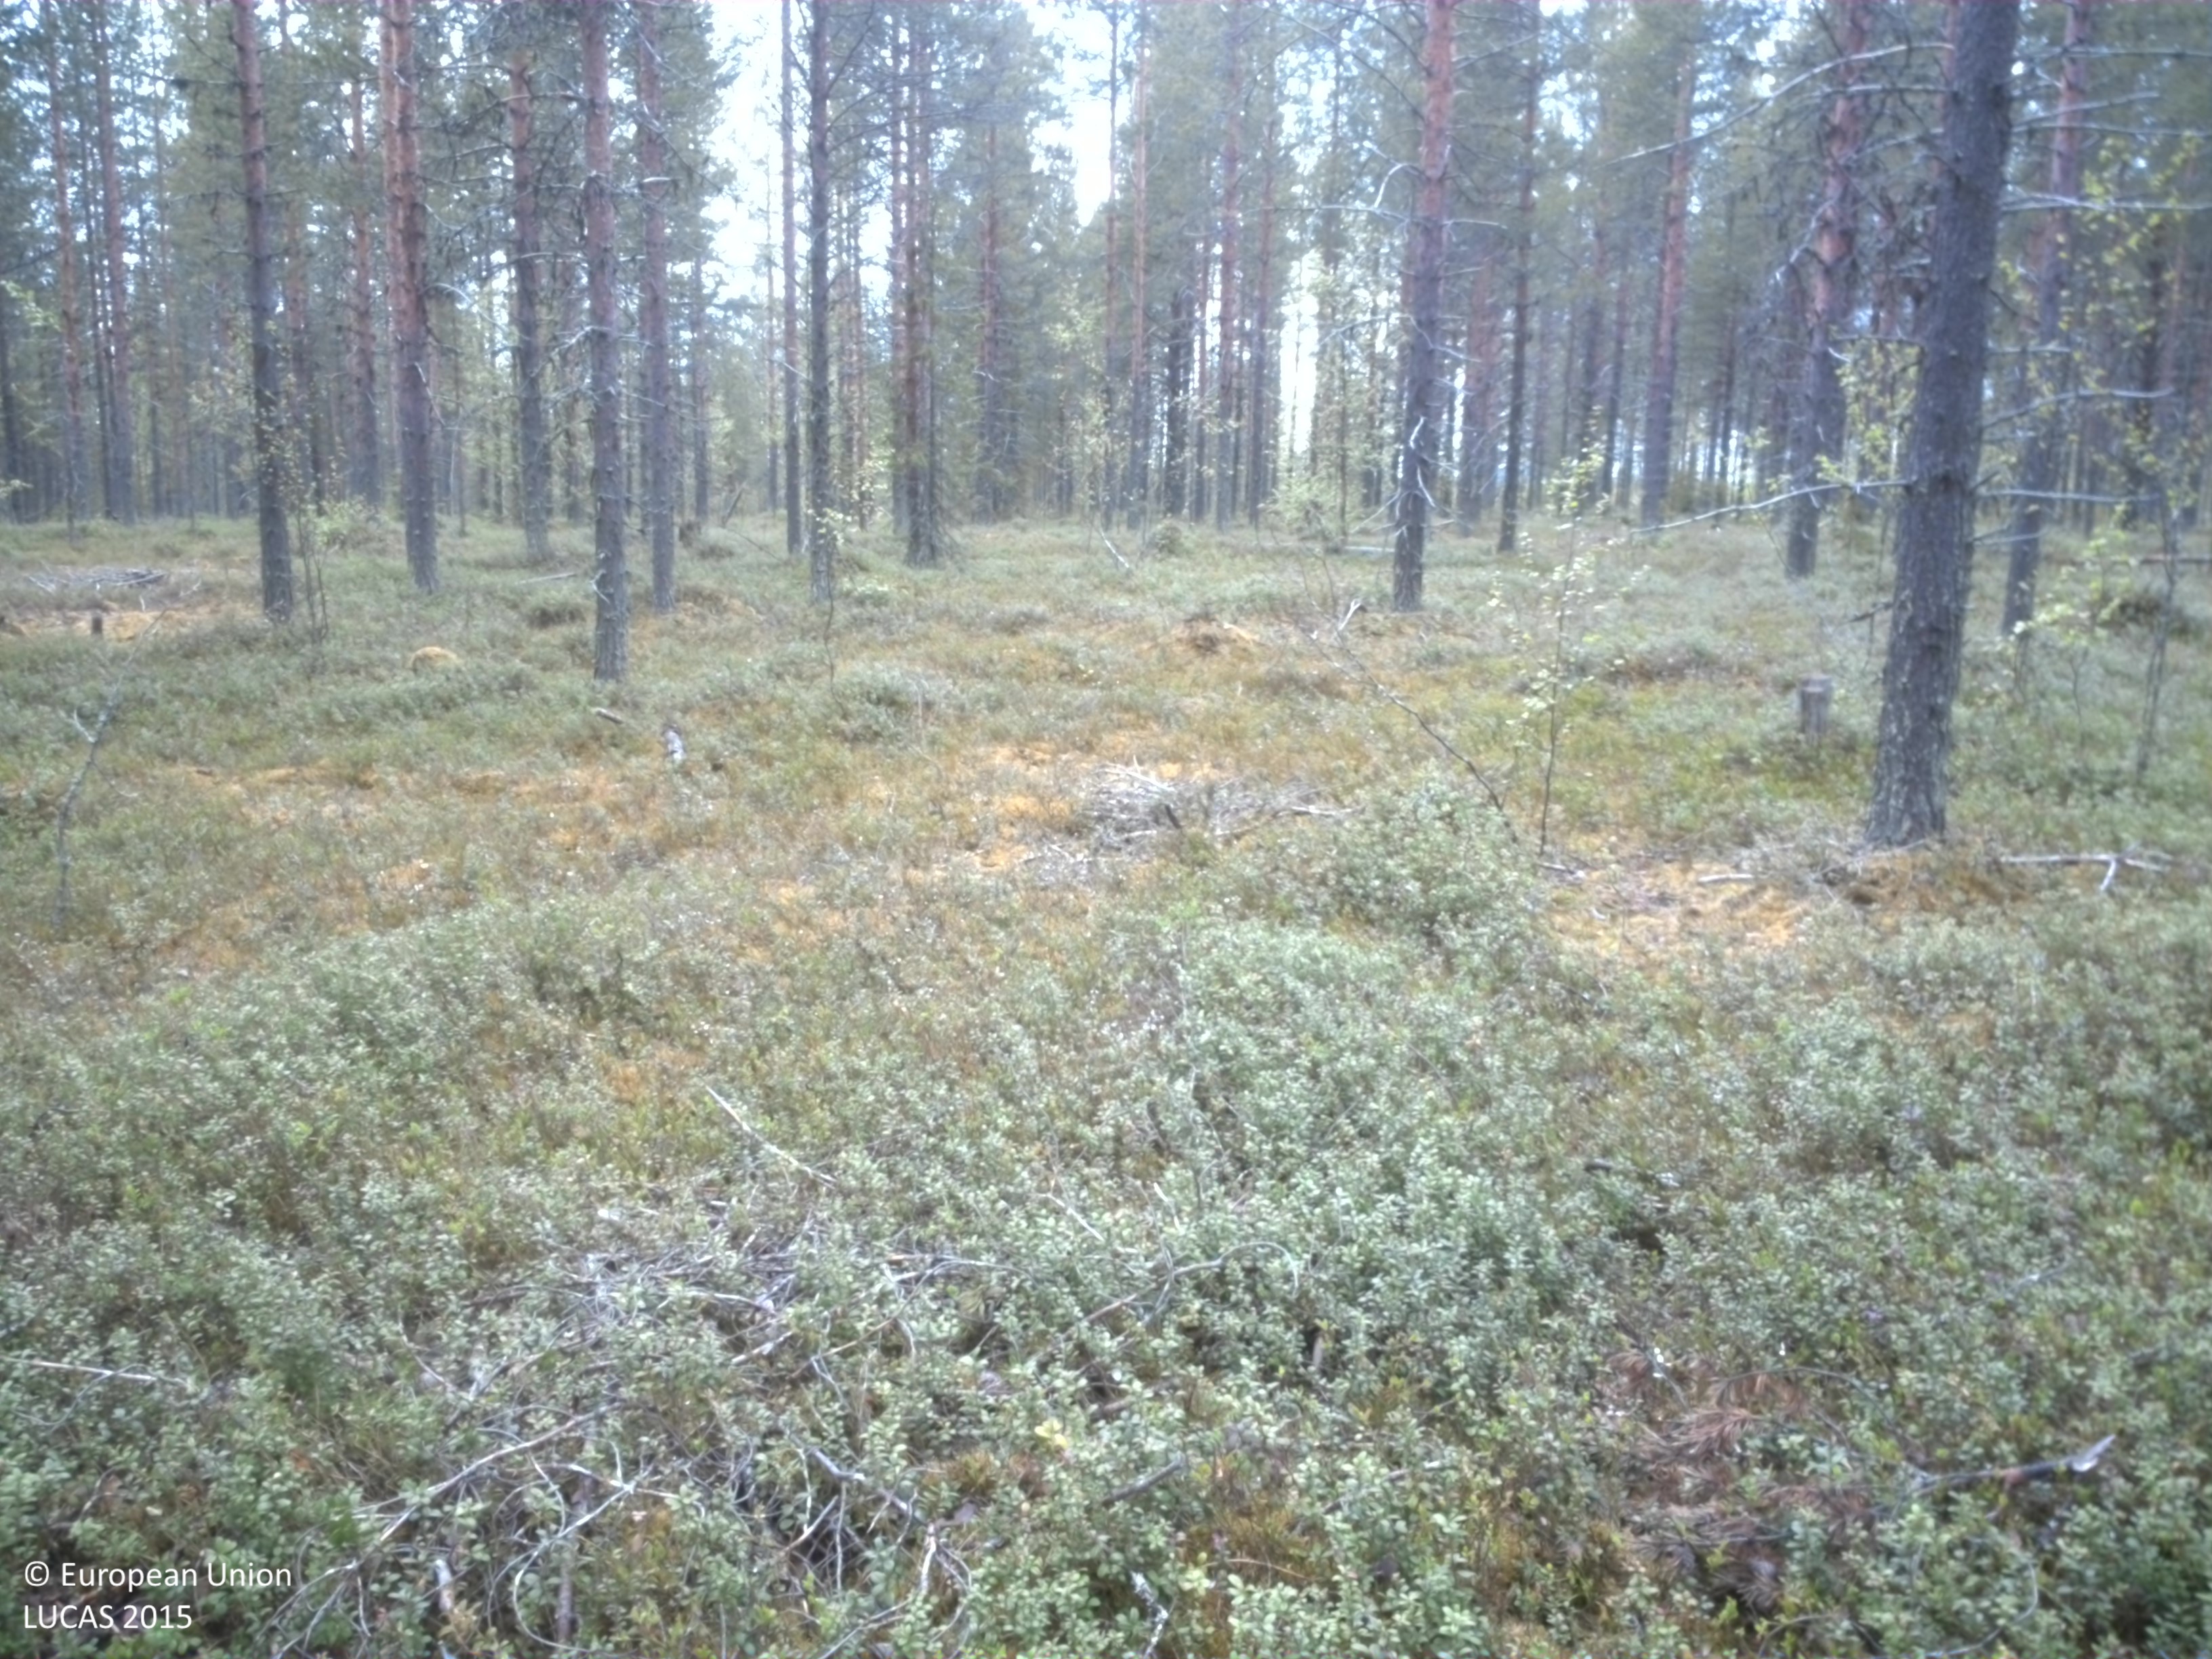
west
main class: Woodland
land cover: Pine dominated coniferous woodland
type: boreal forest
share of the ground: 25 - 50 %
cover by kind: shrubs 55 %, coniferous forest trees 35 %, broadleaved forest trees 5 %, lichens and mosses 5 %
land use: Forestry
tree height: > 5 m
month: June
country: SE
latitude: 66.8328
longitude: 22.3342
